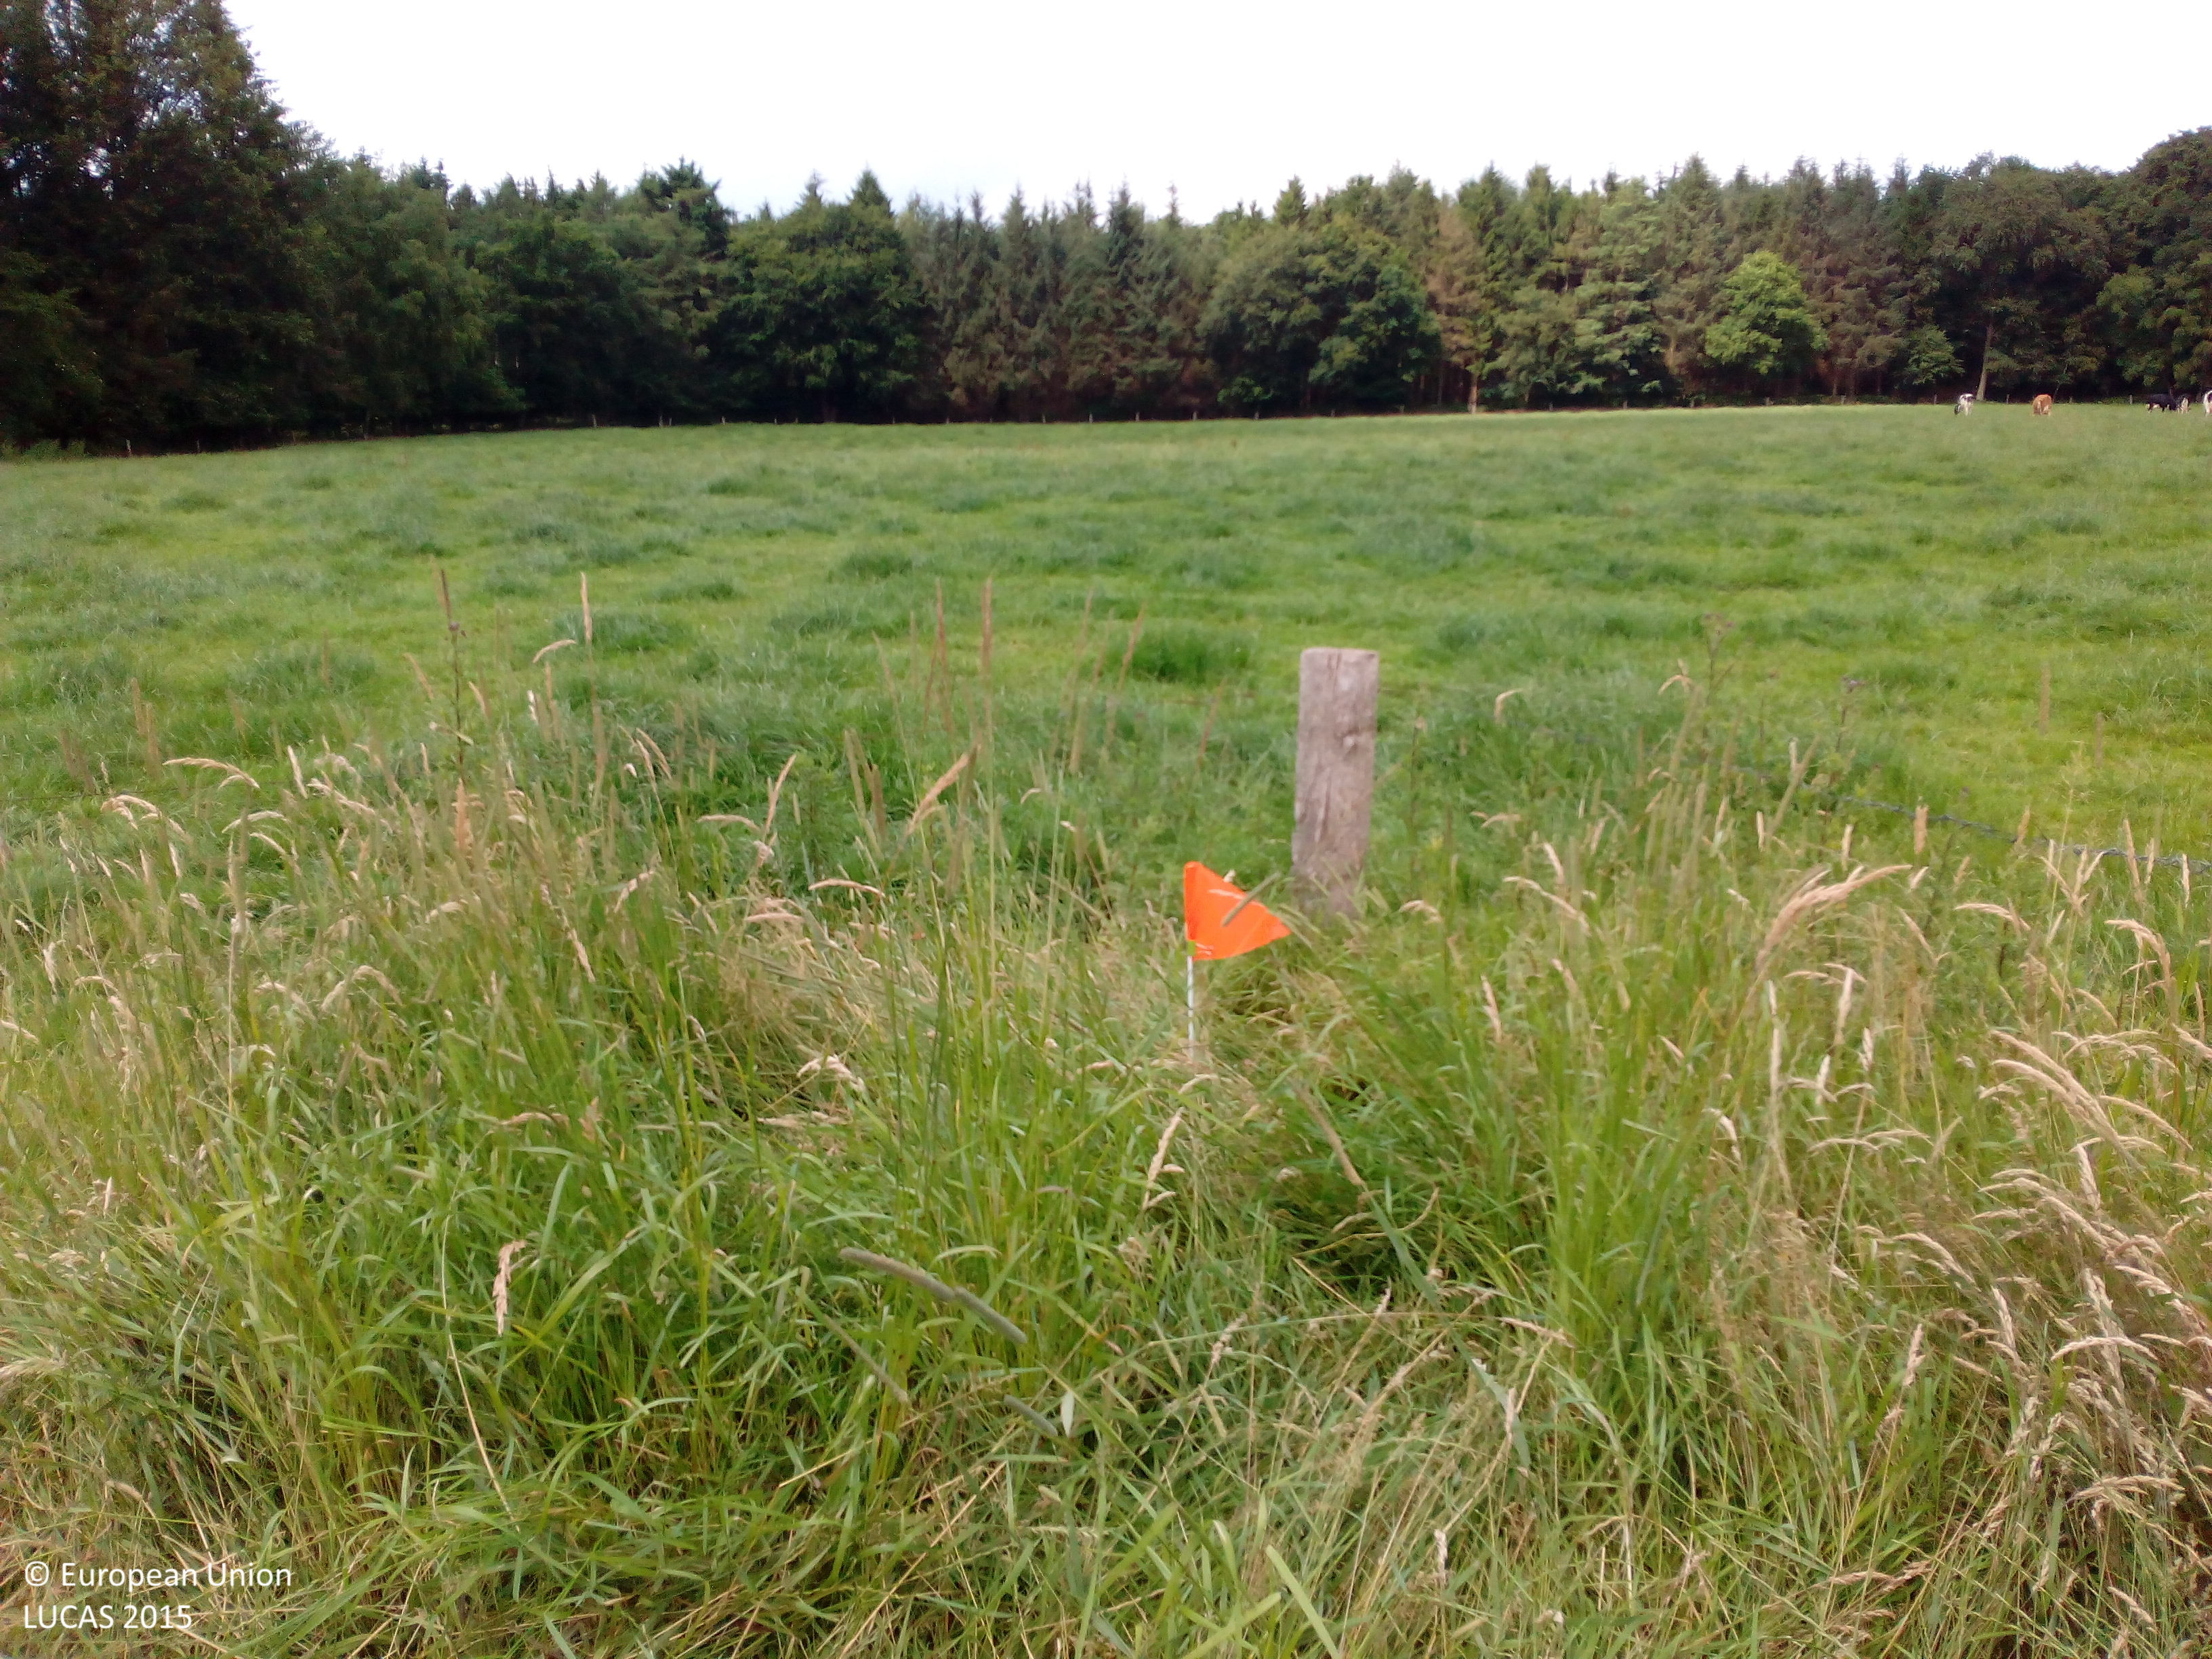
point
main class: Grassland
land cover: Grassland without tree/shrub cover
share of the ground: > 75 %
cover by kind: herbaceous plants 100 %
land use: Agriculture (excluding fallow land and kitchen gardens)
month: July
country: DE
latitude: 53.3126
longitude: 7.9444
